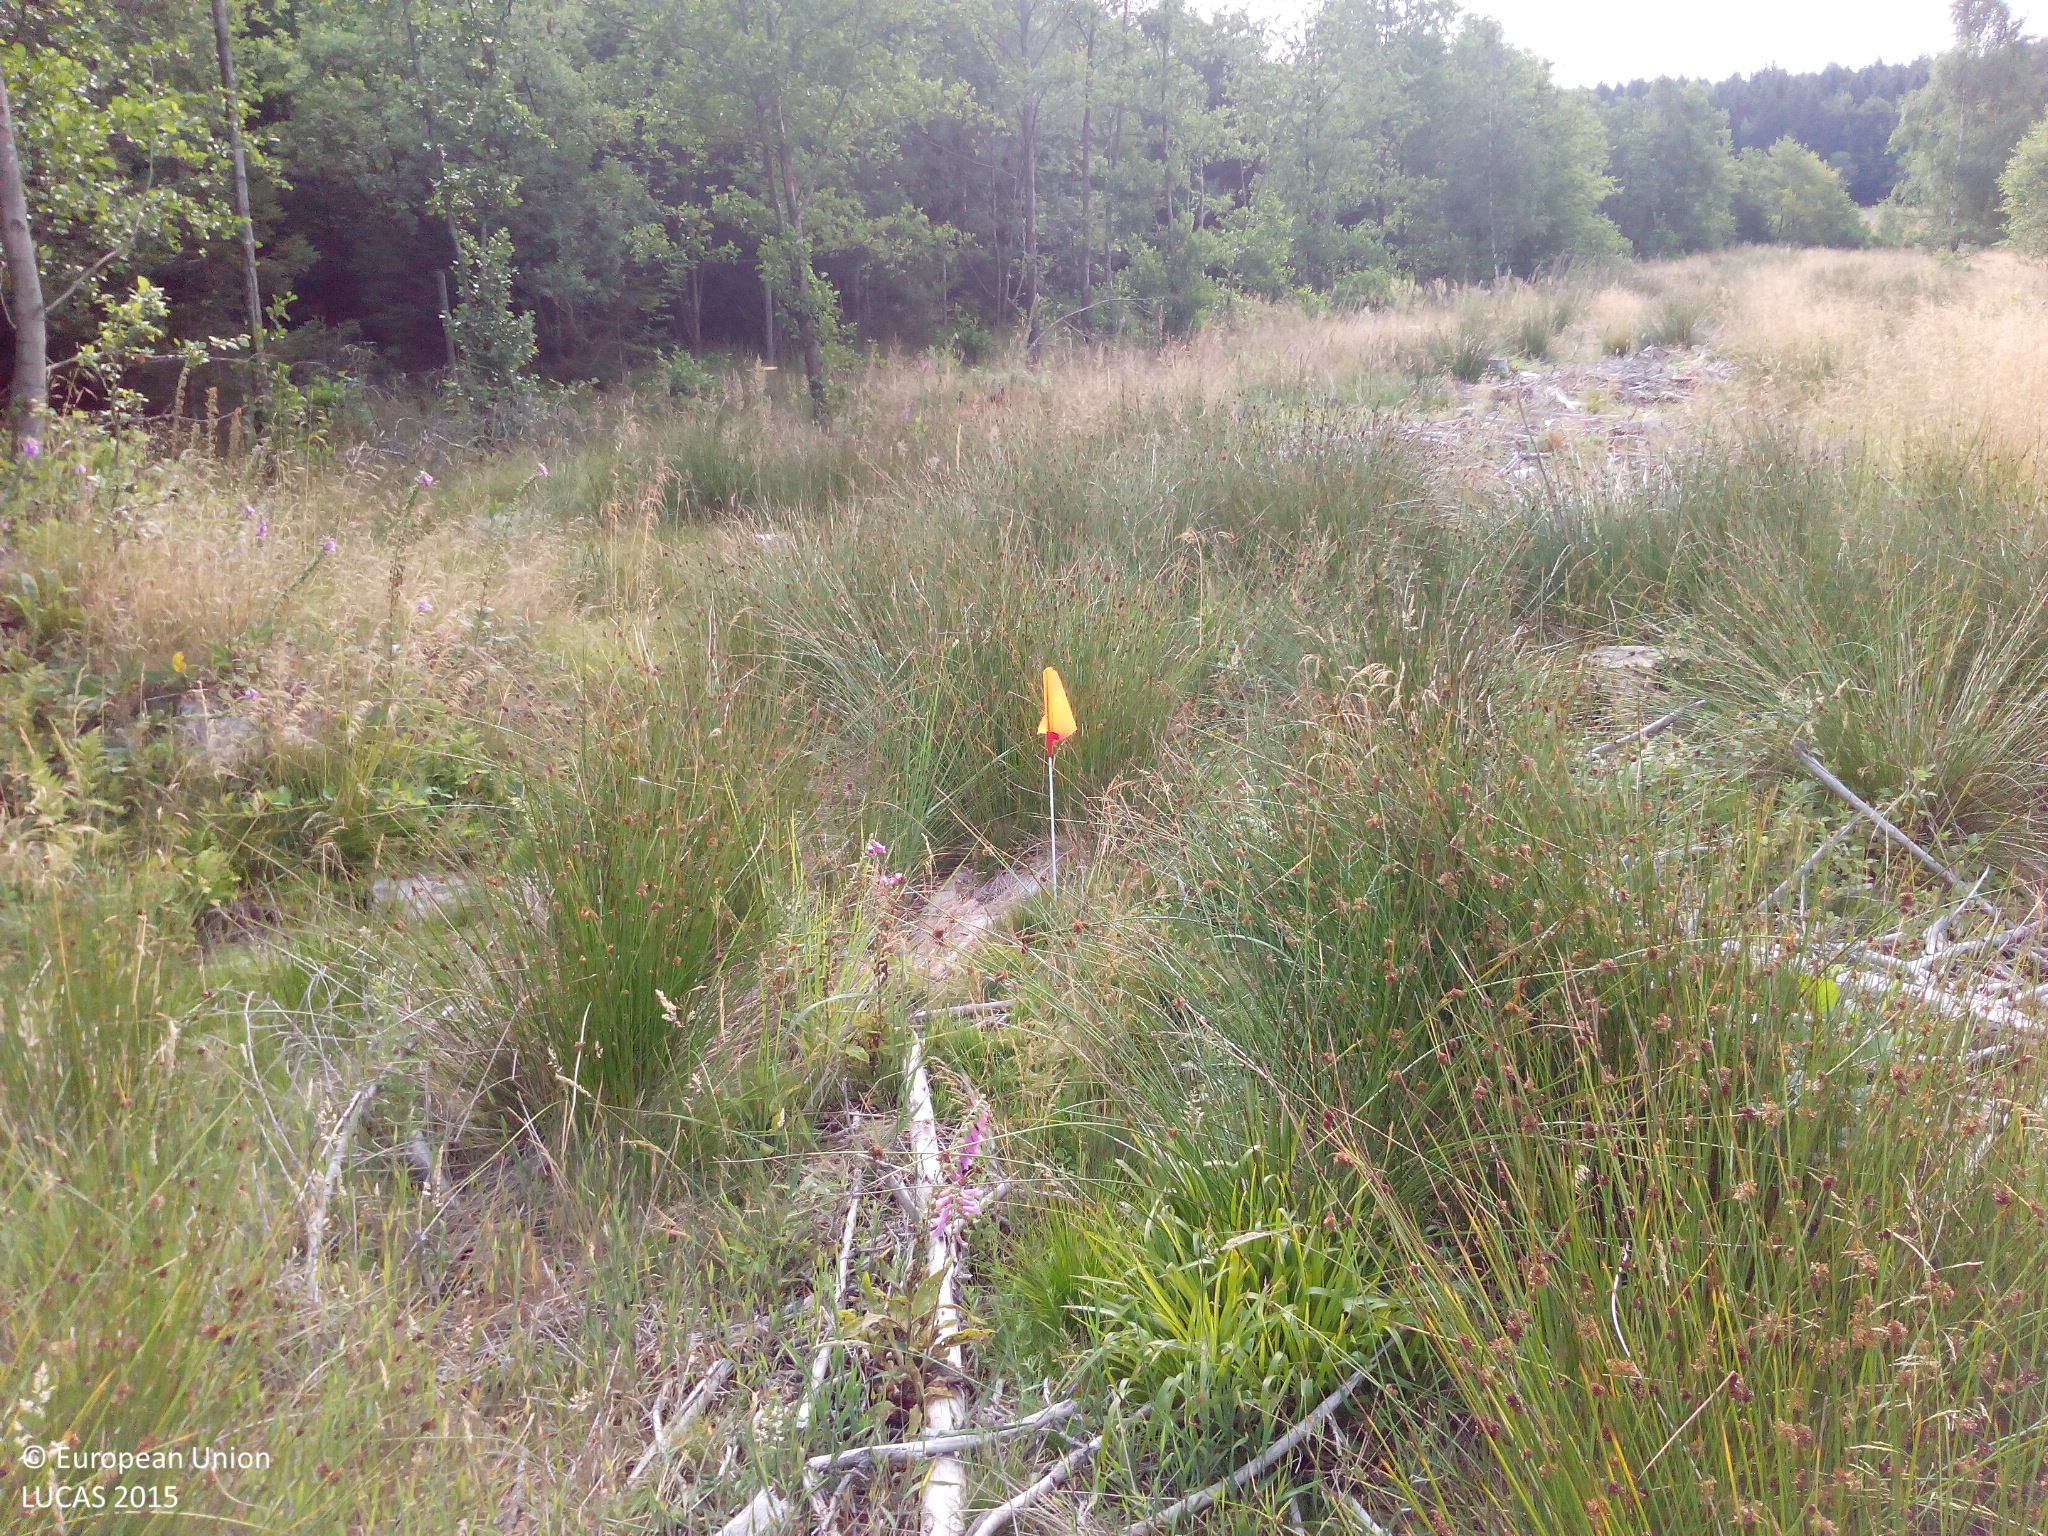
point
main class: Grassland
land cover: Spontaneously vegetated surfaces
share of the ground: > 75 %
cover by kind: herbaceous plants 80 %, shrubs 5 %, unconsolidated bare surface 5 %
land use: Forestry
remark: Clear cut
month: July
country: DE
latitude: 49.9070
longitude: 7.5915
